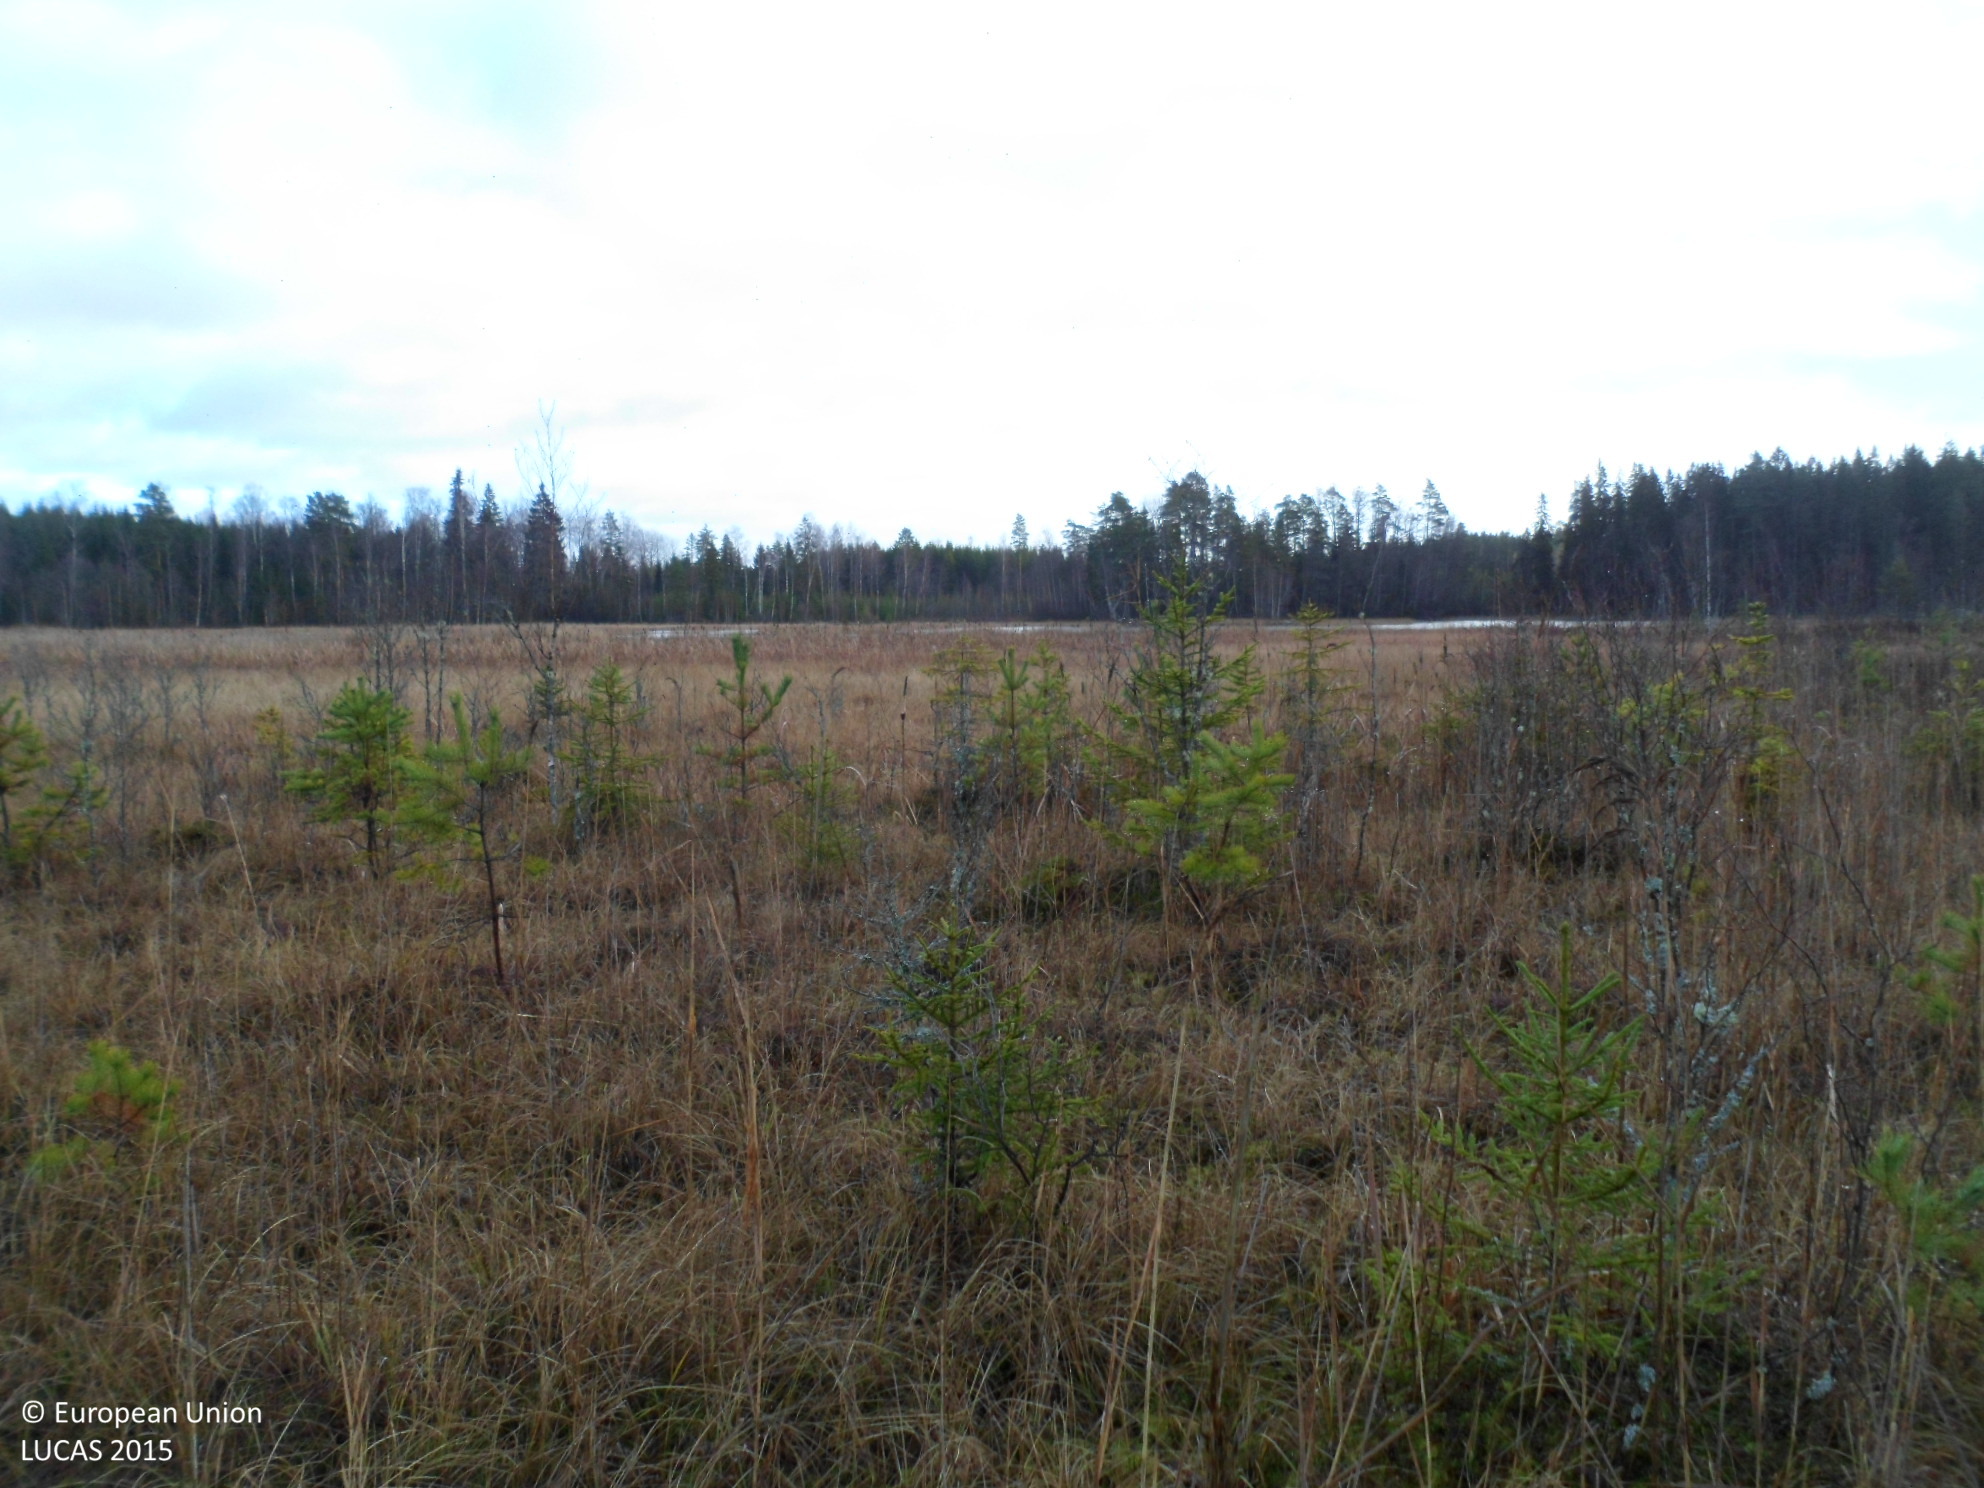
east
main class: Woodland
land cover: Pine dominated mixed woodland
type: mire and swamp forests
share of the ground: 10 - 25 %
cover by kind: lichens and mosses 40 %, herbaceous plants 30 %, coniferous forest trees 10 %, broadleaved forest trees 10 %, shrubs 10 %
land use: Semi-natural and natural areas not in use
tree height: < 5 m
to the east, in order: Pine dominated mixed woodland; Inland marshes; Inland fresh water bodies; Inland marshes
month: November
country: SE
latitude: 57.5625
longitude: 15.9986
